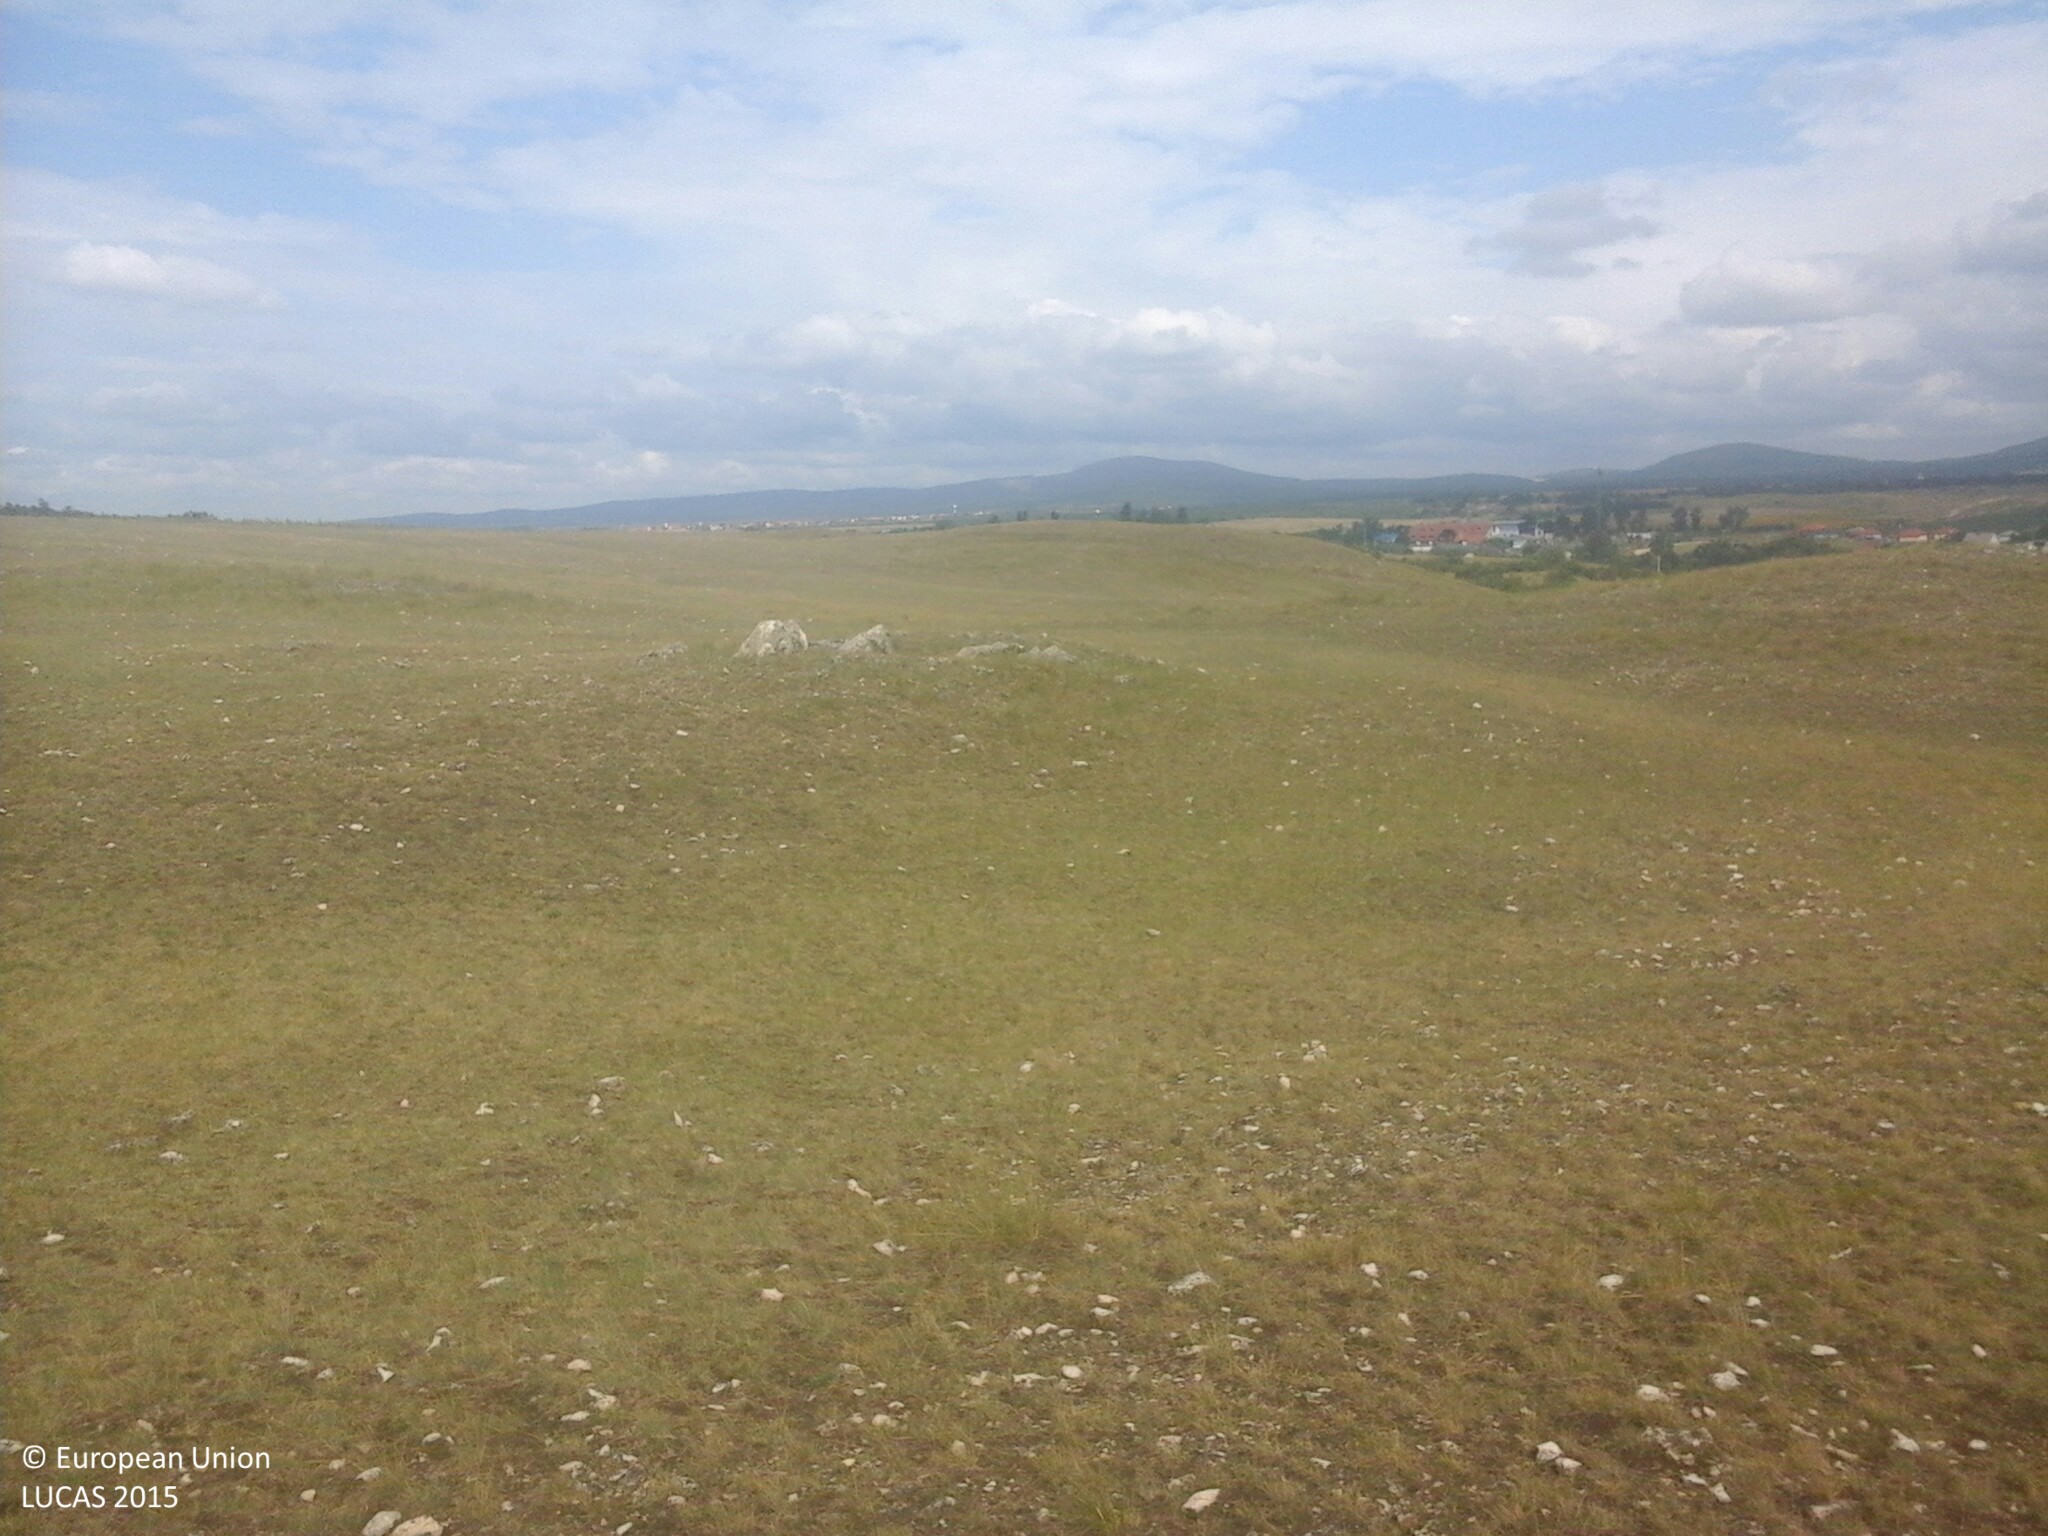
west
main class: Grassland
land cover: Grassland without tree/shrub cover
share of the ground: > 75 %
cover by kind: herbaceous plants 80 %, consolidated bare surface 20 %
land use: Semi-natural and natural areas not in use
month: July
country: HU
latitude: 47.1358
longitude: 18.0127
